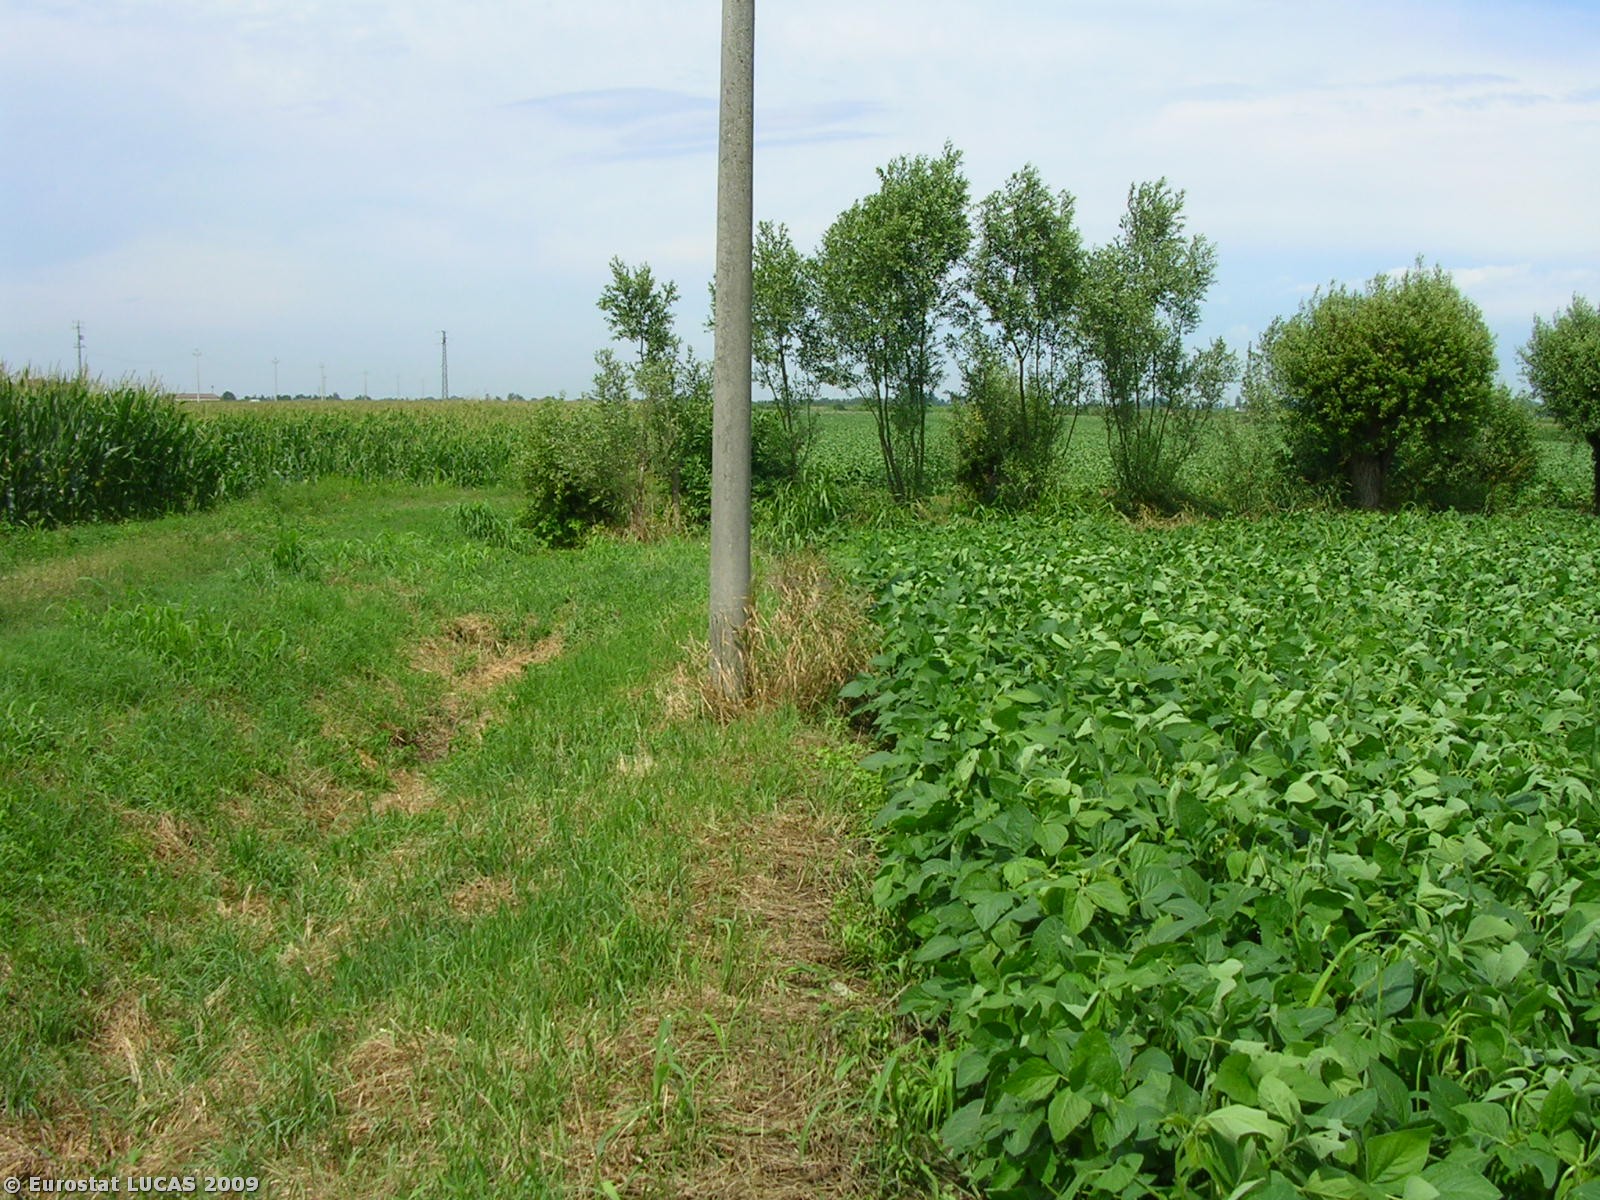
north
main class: Cropland
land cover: Soya
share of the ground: > 75 %
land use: Agriculture (excluding fallow land and kitchen gardens)
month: July
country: IT
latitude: 45.2131
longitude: 12.0974
